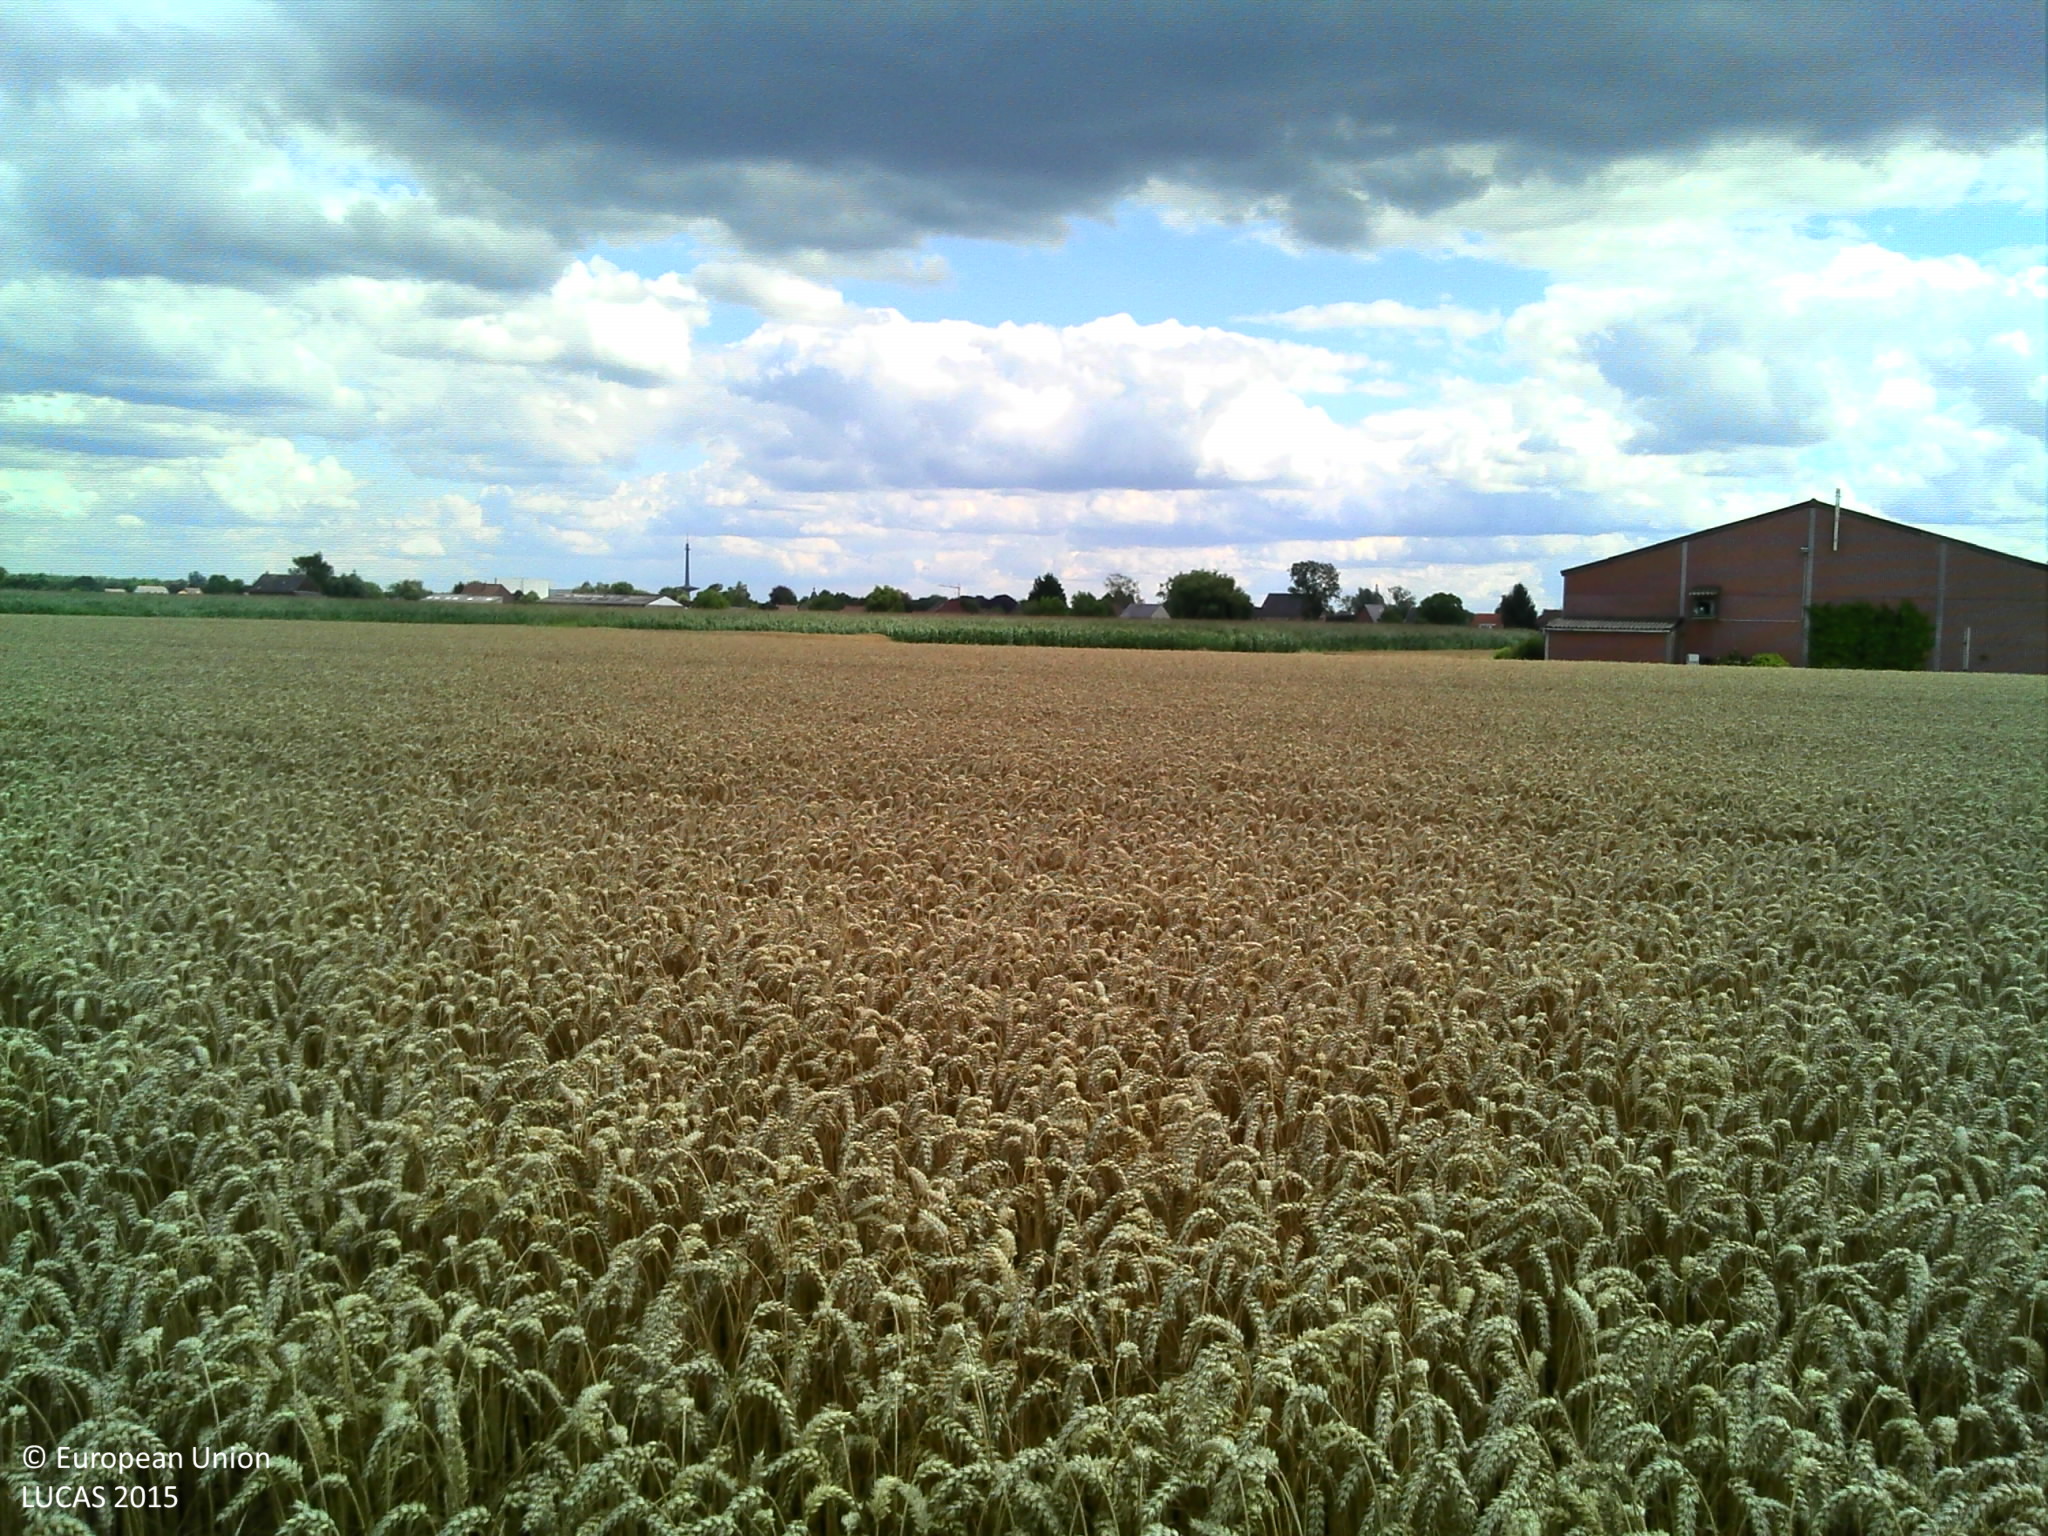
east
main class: Cropland
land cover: Common wheat
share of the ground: > 75 %
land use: Agriculture (excluding fallow land and kitchen gardens)
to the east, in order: Common wheat; Tracks; Maize; Ditches and canals; Grass margins; Paved roads, cycling and walking lanes; Grass margins; Ditches and canals; Common wheat; Maize
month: July
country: BE
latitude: 51.0210
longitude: 4.4214
